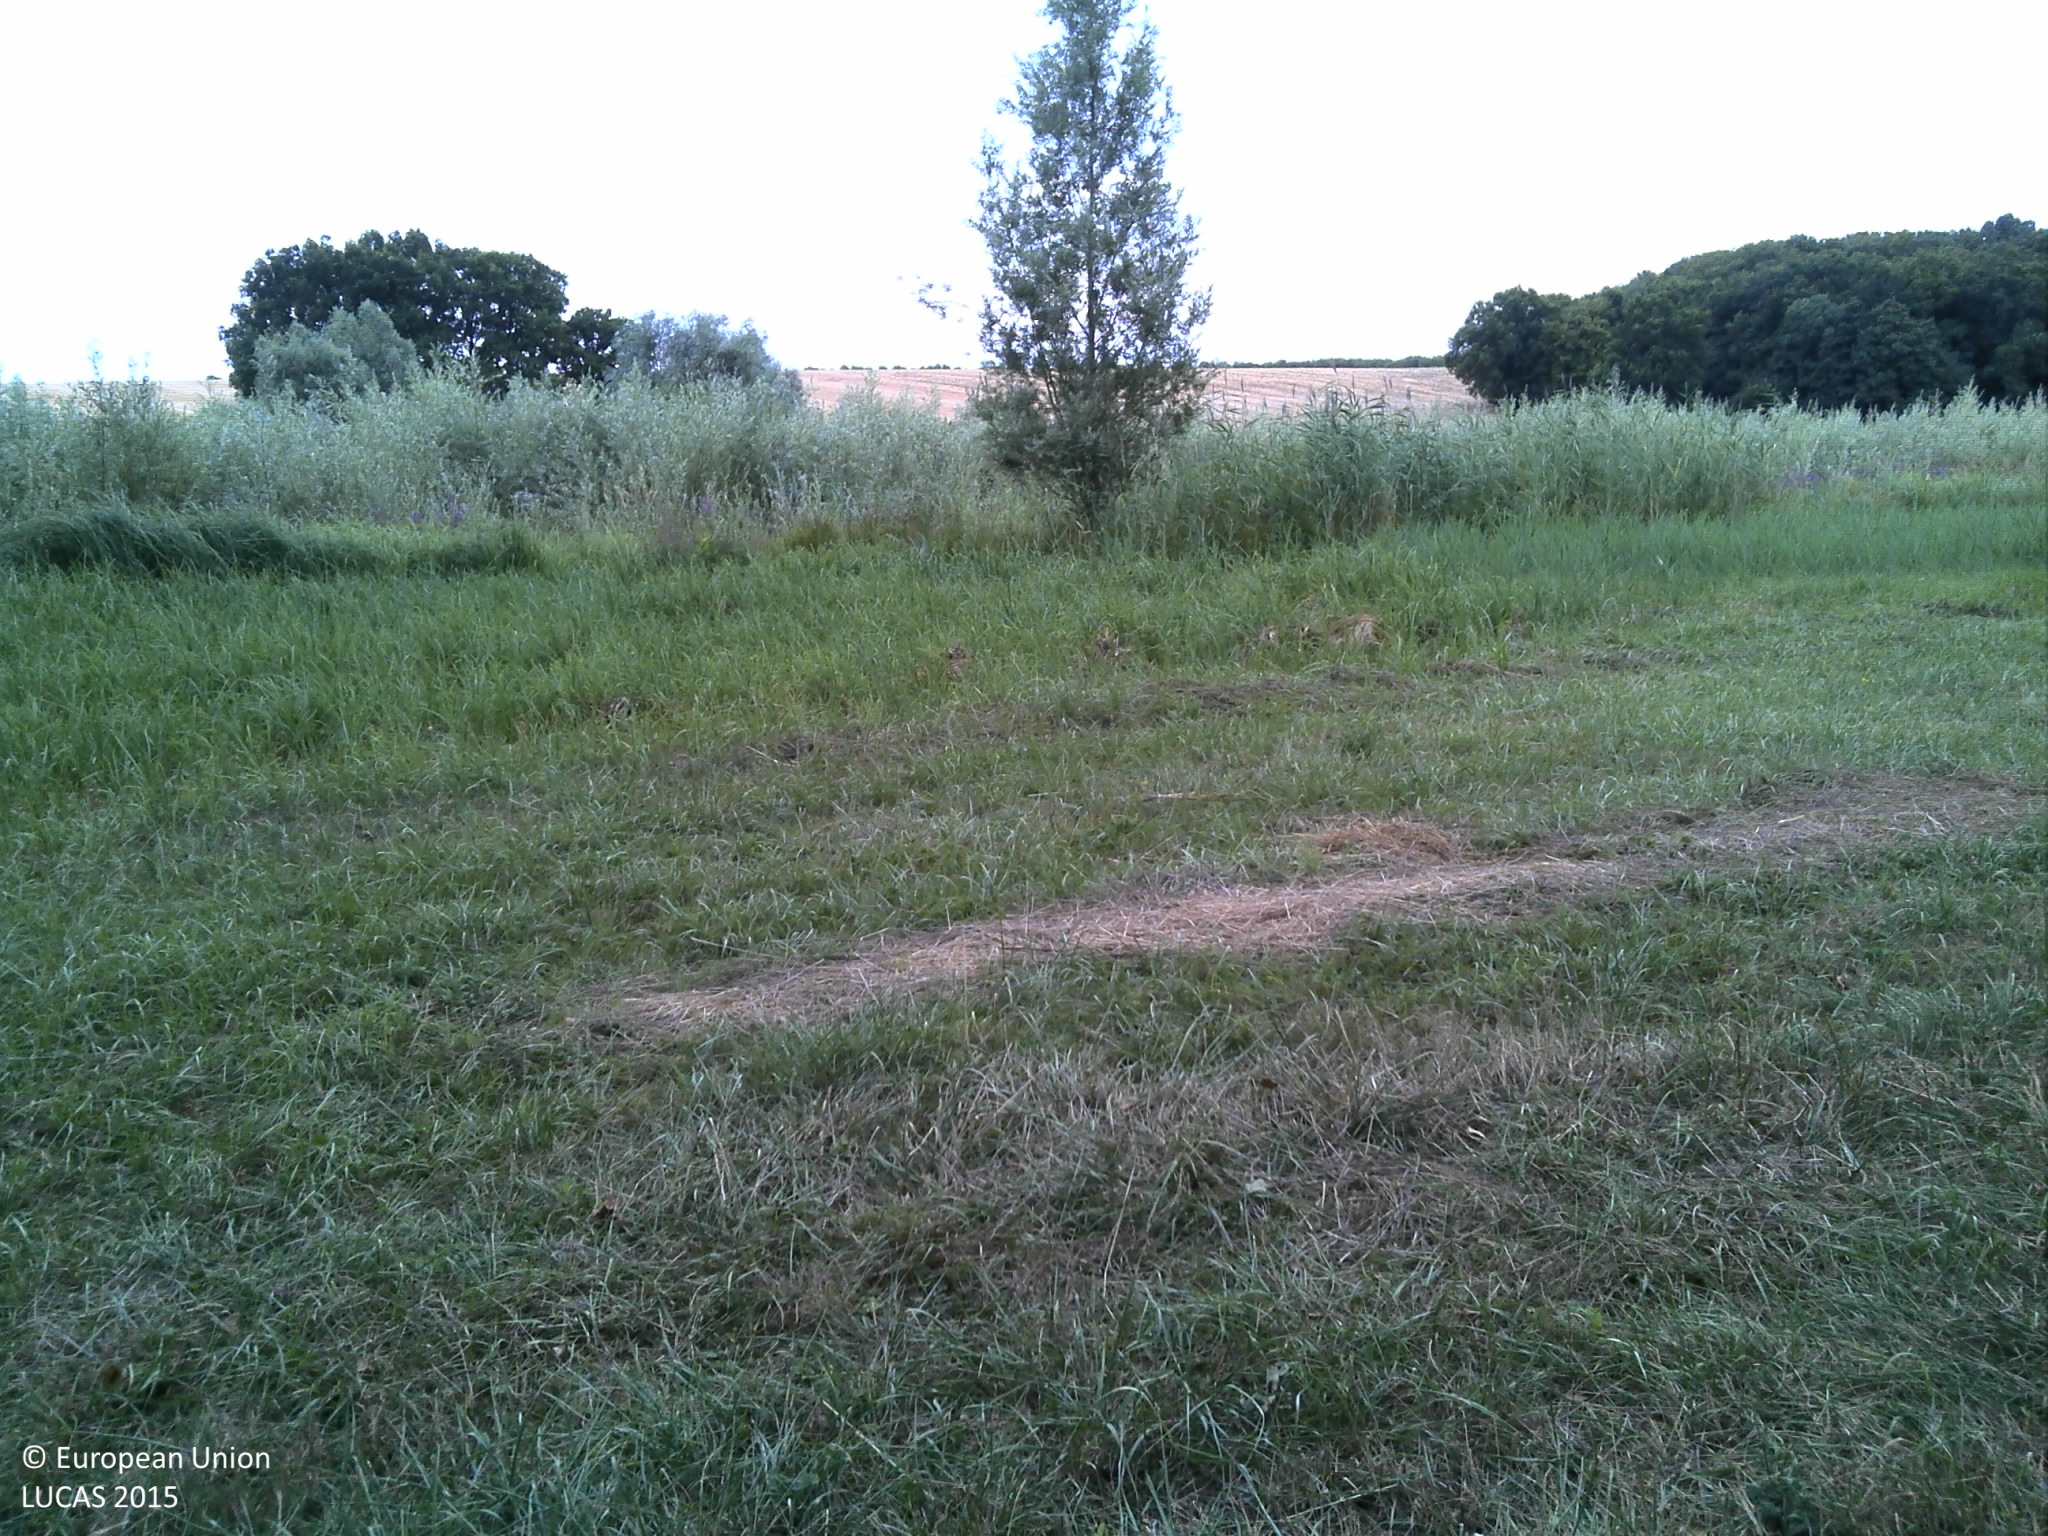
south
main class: Grassland
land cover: Grassland with sparse tree/shrub cover
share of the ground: > 75 %
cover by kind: herbaceous plants 95 %, broadleaved forest trees 5 %
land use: Agriculture (excluding fallow land and kitchen gardens)
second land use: Amenities, museums, leisure
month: July
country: FR
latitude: 48.5776
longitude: 4.5891
